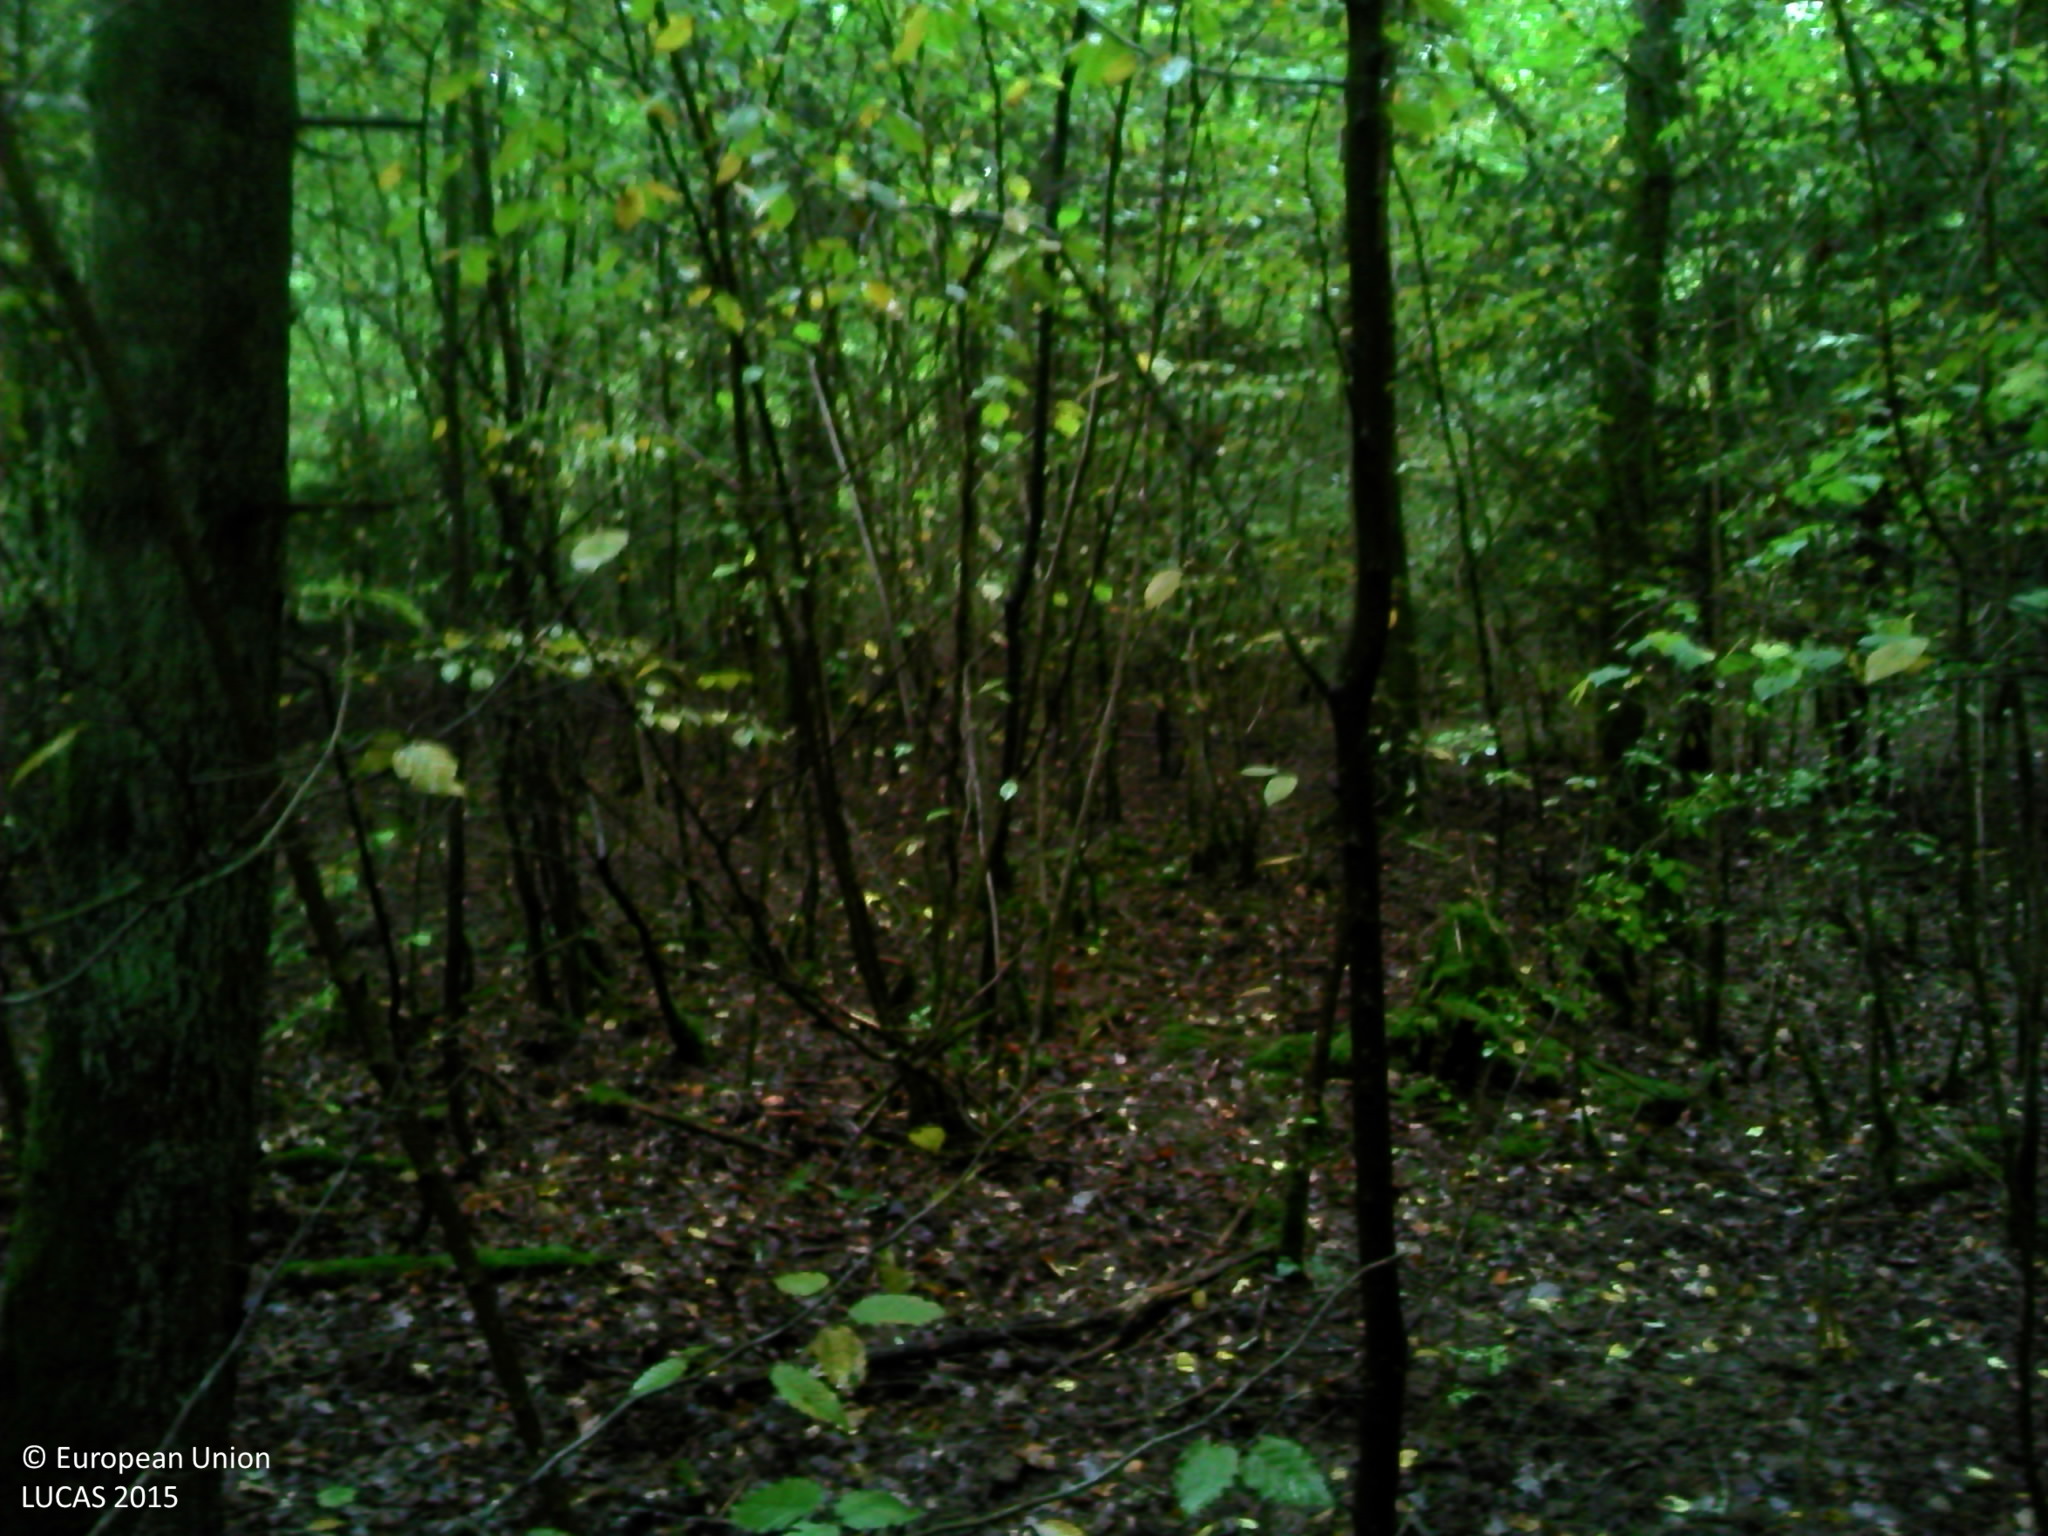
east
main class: Woodland
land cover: Spruce dominated mixed woodland
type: hemiboreal forest and nemoral coniferous forest and mixed broadleaved-coniferous forest
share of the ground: > 75 %
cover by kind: broadleaved forest trees 75 %, coniferous forest trees 25 %
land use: Forestry
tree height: > 5 m
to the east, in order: Spruce dominated mixed woodland; Broadleaved woodland; Ditches and canals; Broadleaved woodland
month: October
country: FR
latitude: 48.2027
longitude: 4.3056
